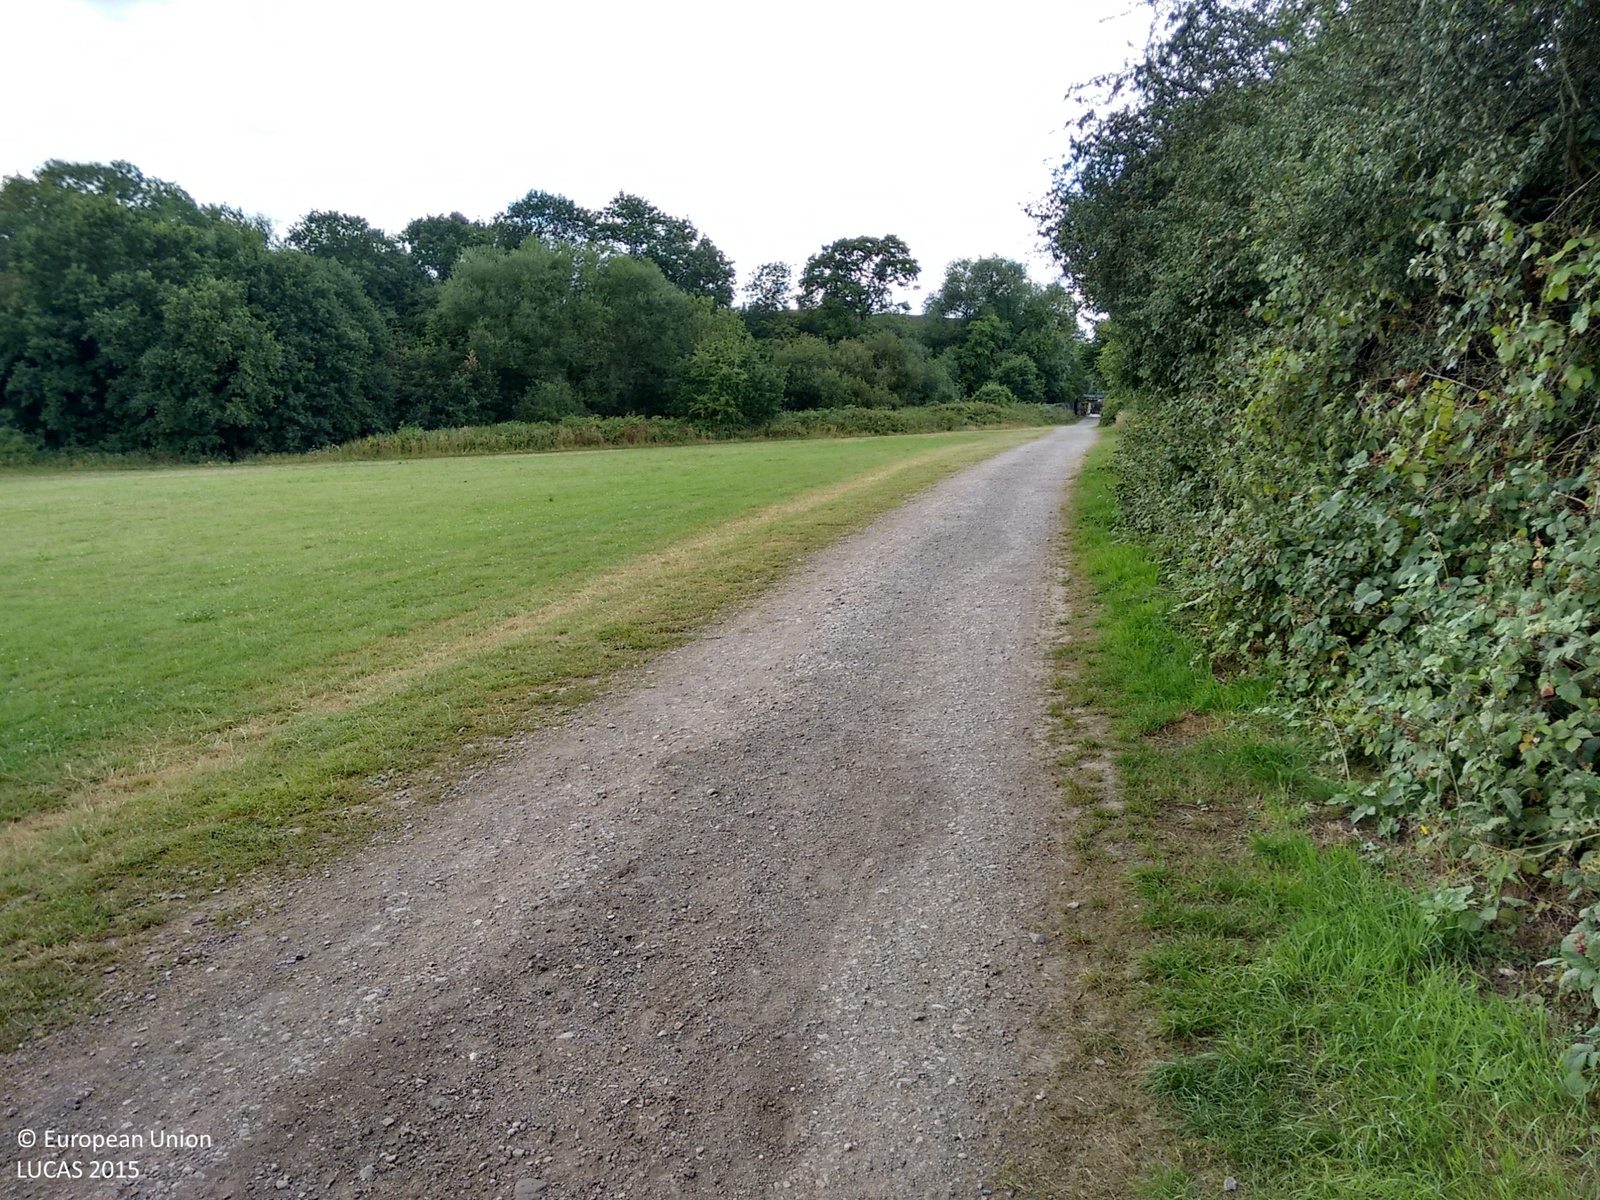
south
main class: Shrubland
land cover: Shrubland with sparse tree cover
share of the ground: > 75 %
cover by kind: shrubs 95 %, broadleaved forest trees 5 %
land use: Agriculture (excluding fallow land and kitchen gardens)
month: July
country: GB
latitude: 51.5510
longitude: -0.4648
